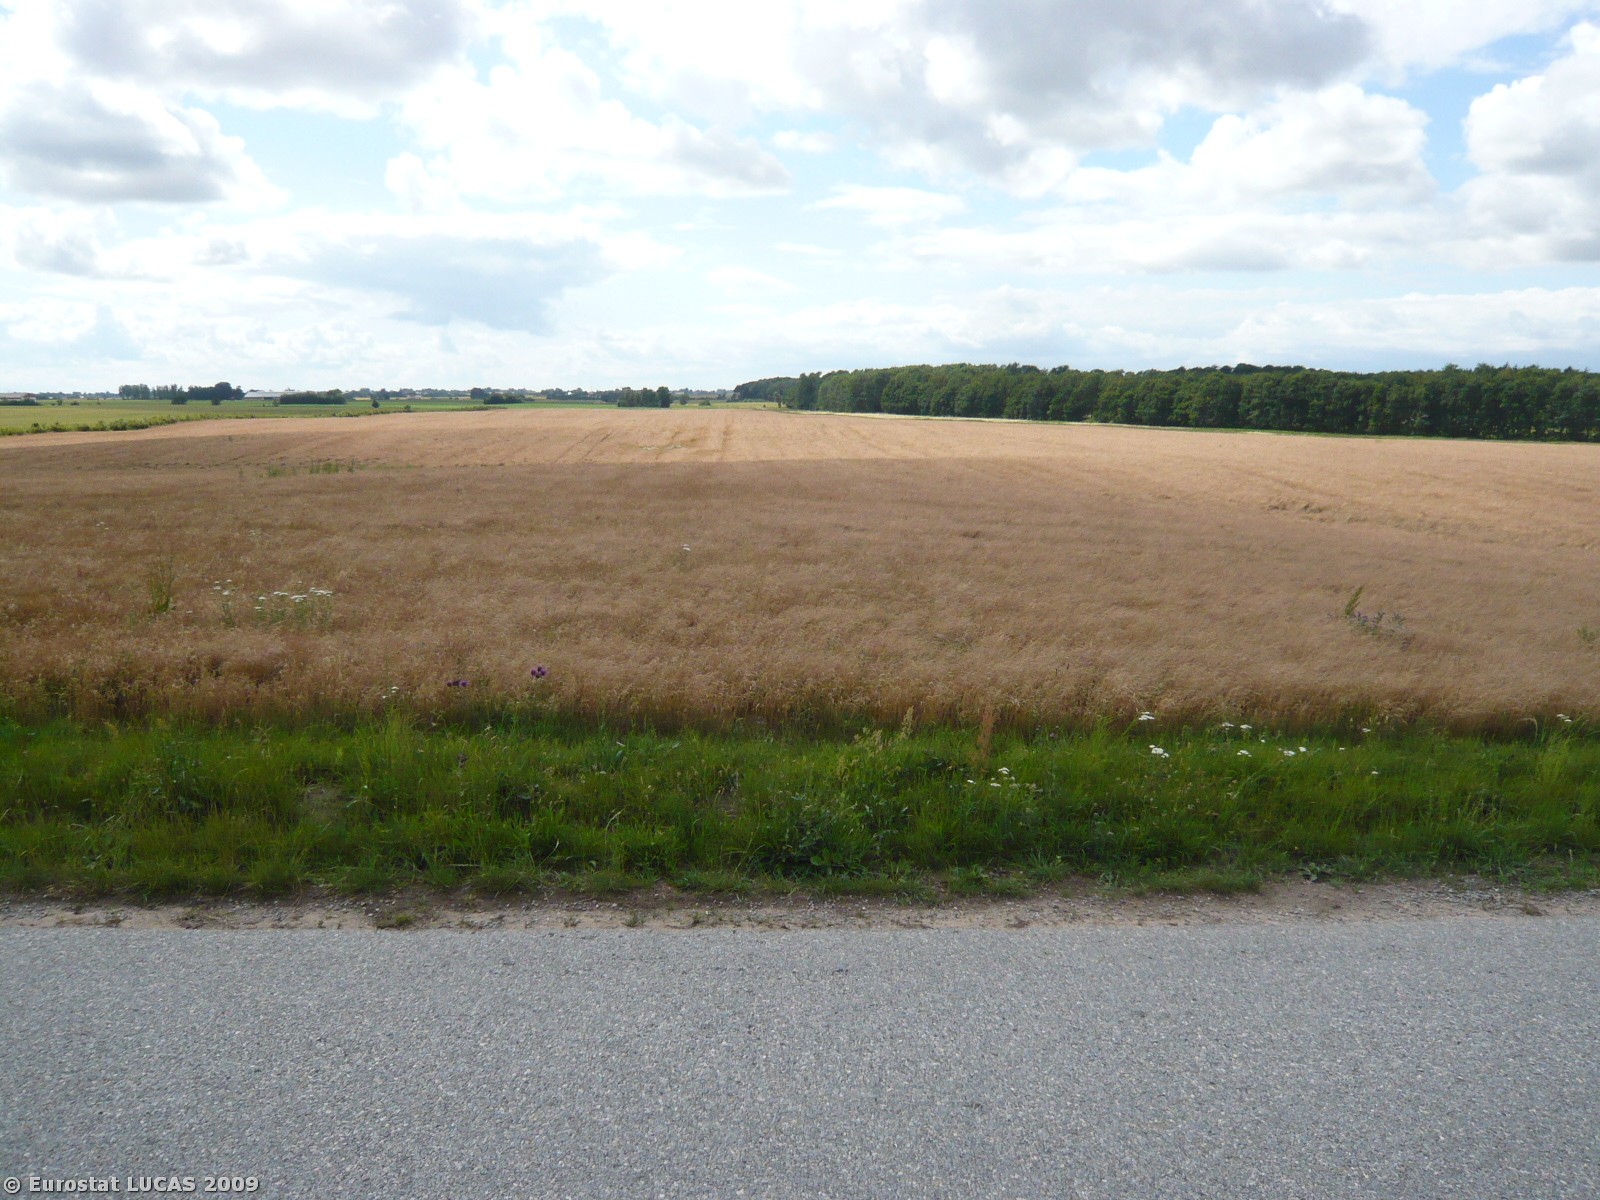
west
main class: Cropland
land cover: Common wheat
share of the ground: > 75 %
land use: Agriculture (excluding fallow land and kitchen gardens)
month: July
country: DK
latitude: 55.4965
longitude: 11.4392
